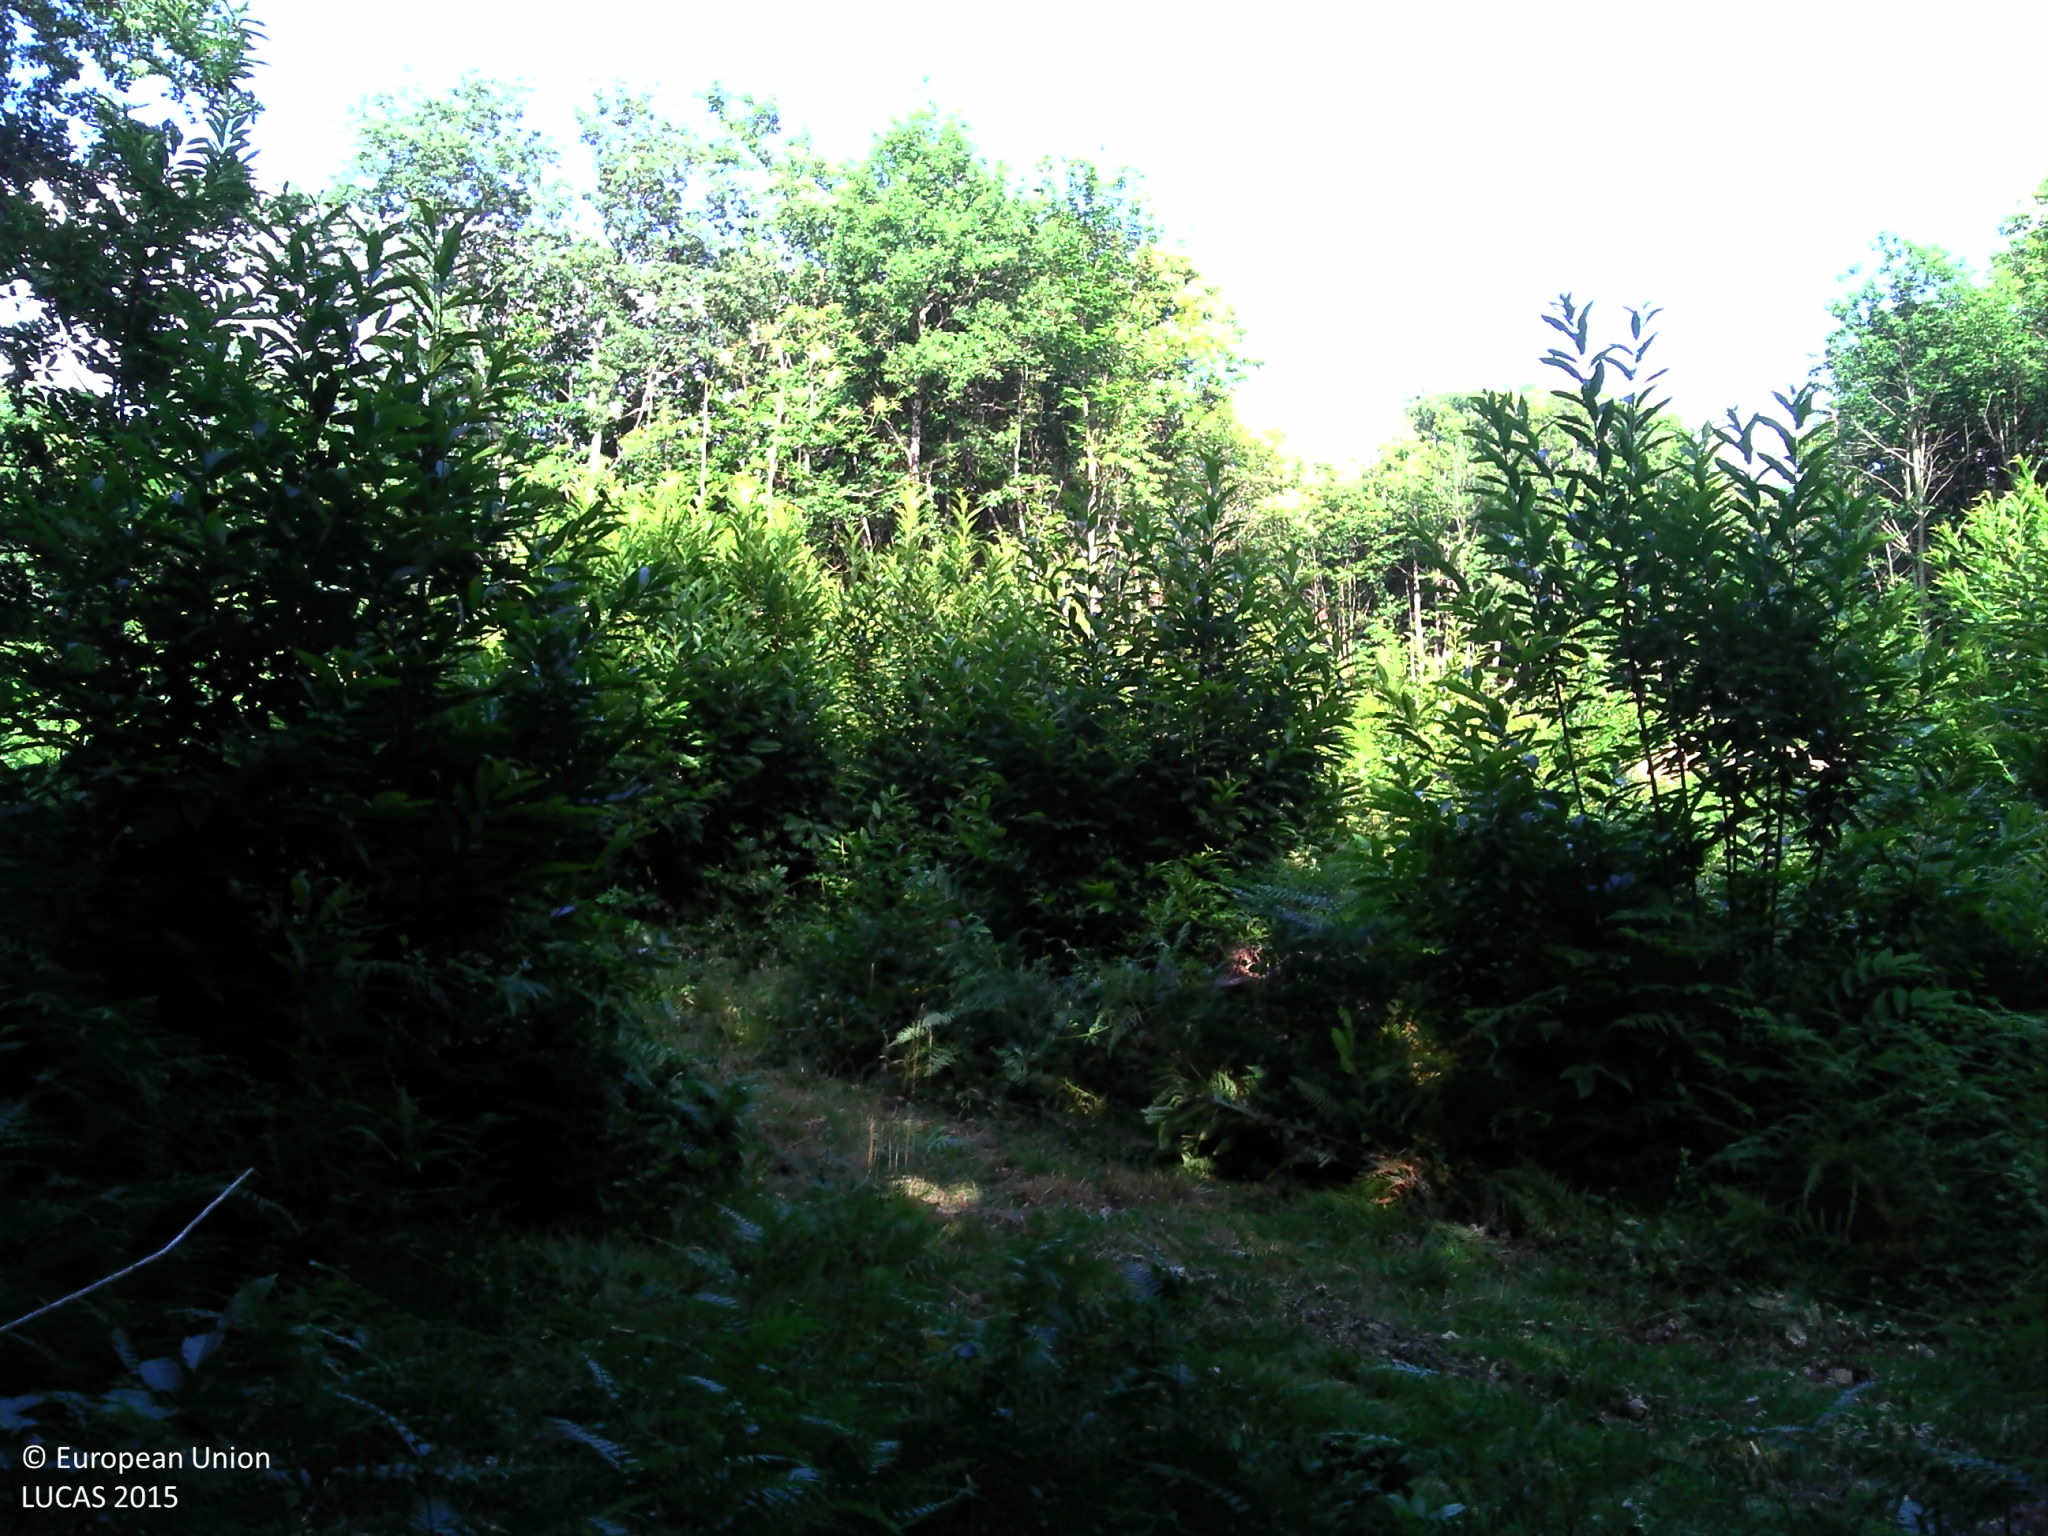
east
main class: Woodland
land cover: Broadleaved woodland
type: boreal forest
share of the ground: > 75 %
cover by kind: broadleaved forest trees 70 %, shrubs 20 %, herbaceous plants 5 %, lichens and mosses 5 %
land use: Forestry
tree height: > 5 m
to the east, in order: Broadleaved woodland; Tracks; Broadleaved woodland; Tracks; Broadleaved woodland; Tracks; Fences; Nuts trees
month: June
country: FR
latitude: 45.7203
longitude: 0.4137
